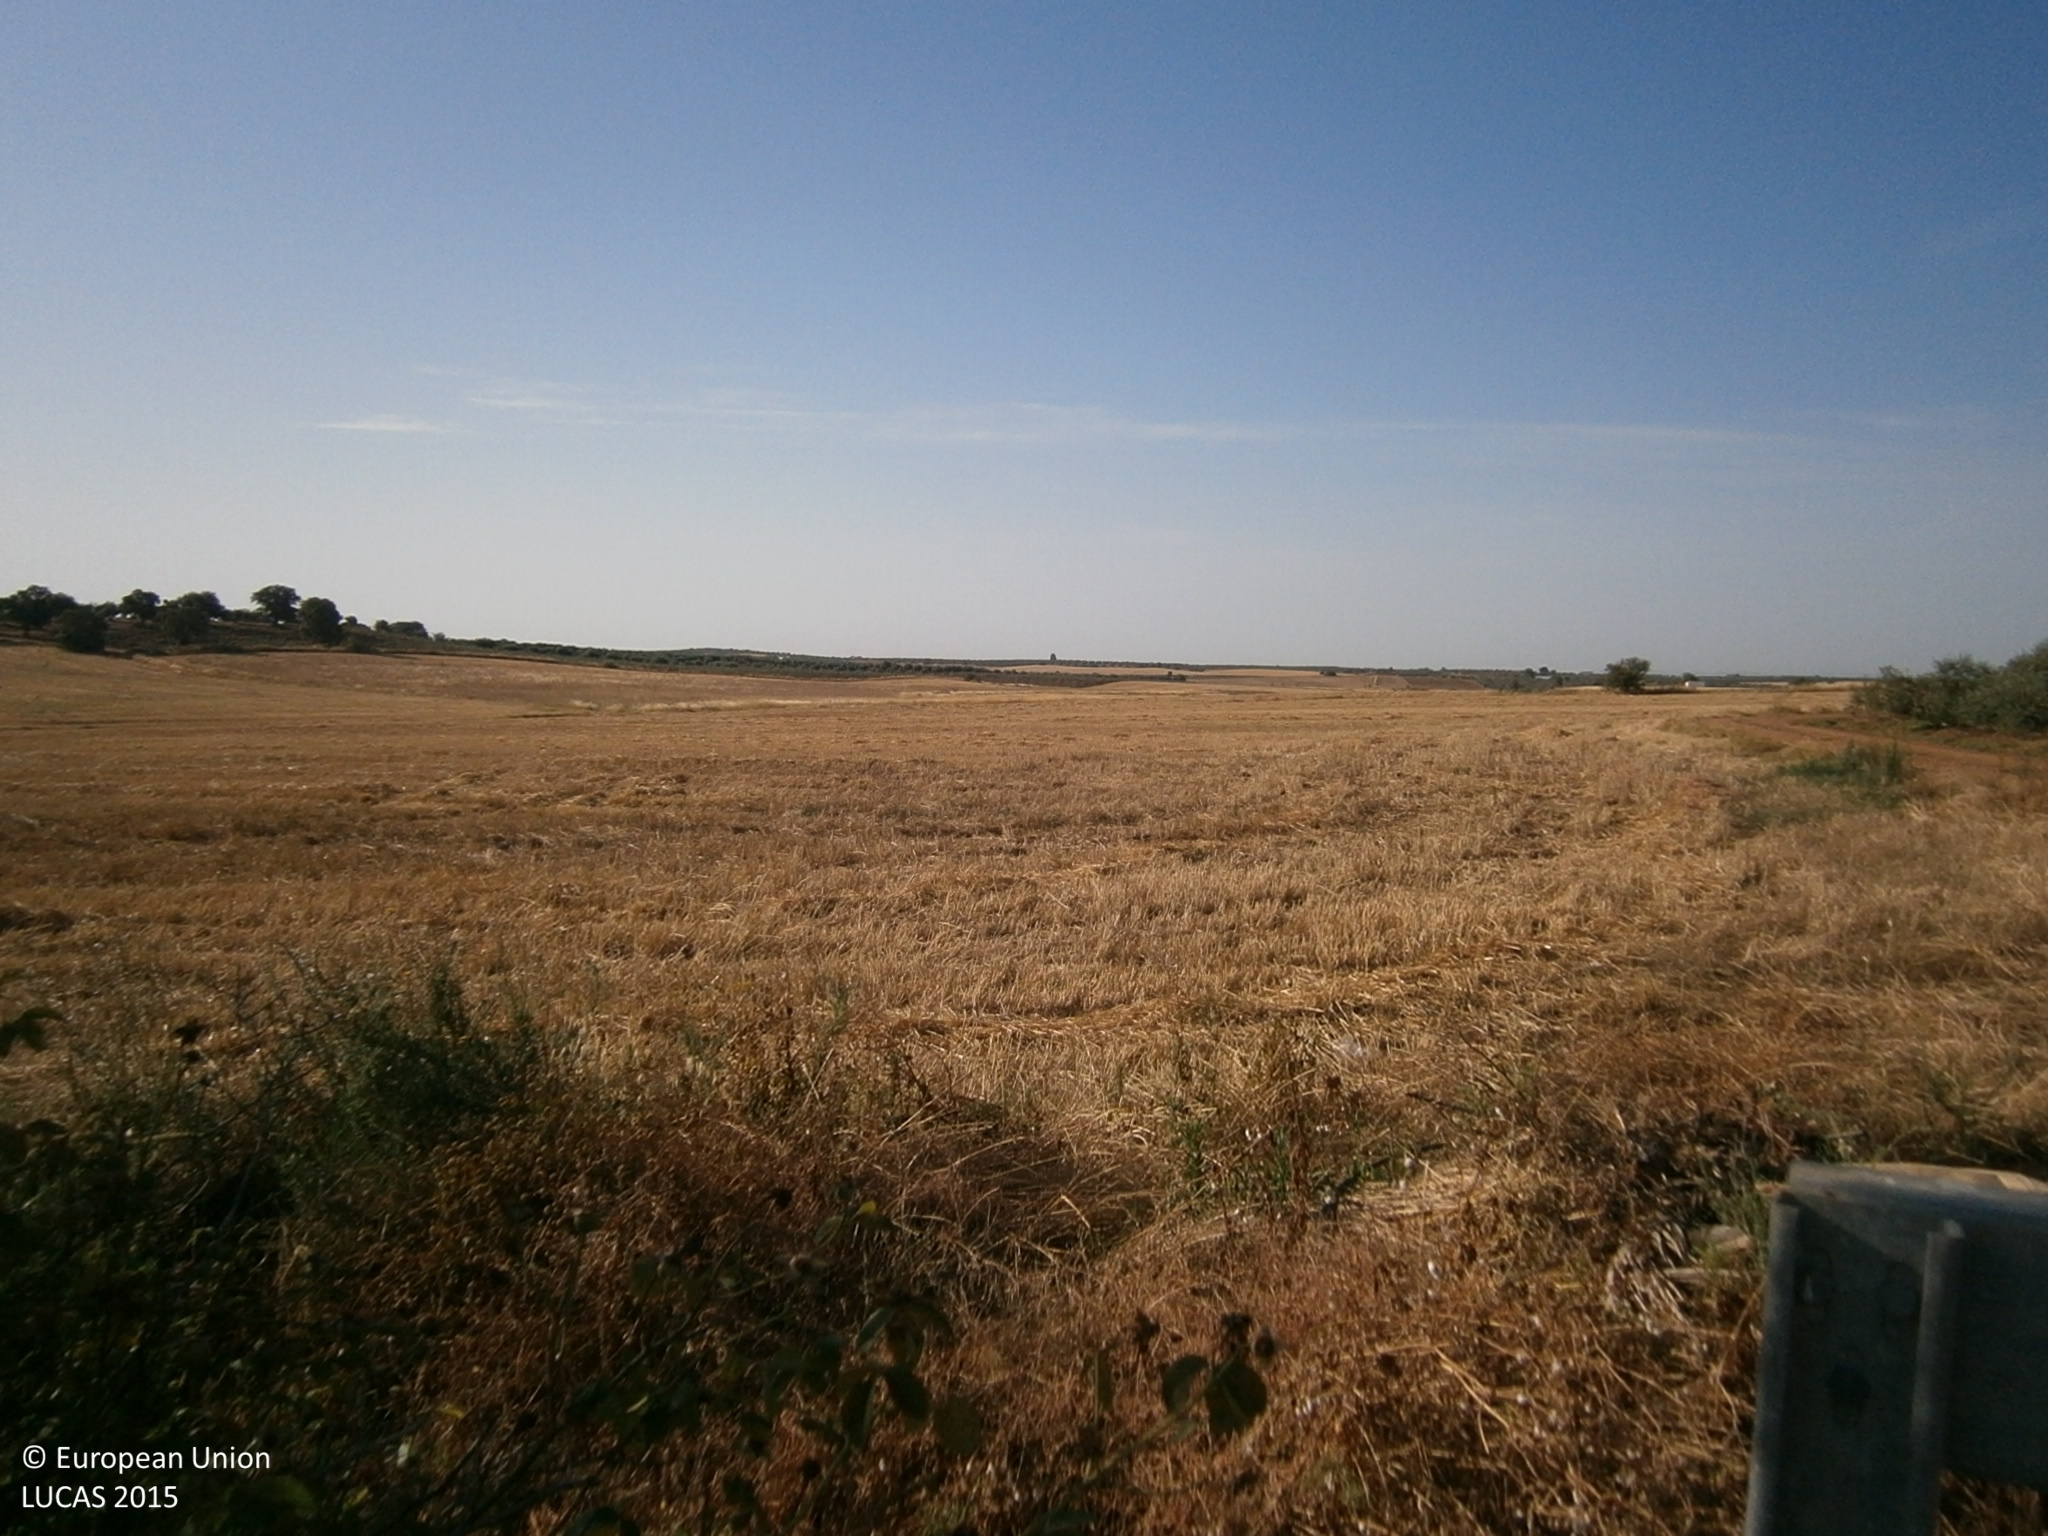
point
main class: Grassland
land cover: Grassland with sparse tree/shrub cover
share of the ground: > 75 %
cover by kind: herbaceous plants 90 %, broadleaved forest trees 5 %, unconsolidated bare surface 5 %
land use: Agriculture (excluding fallow land and kitchen gardens)
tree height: > 5 m
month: July
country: ES
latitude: 38.9900
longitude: -6.7026
